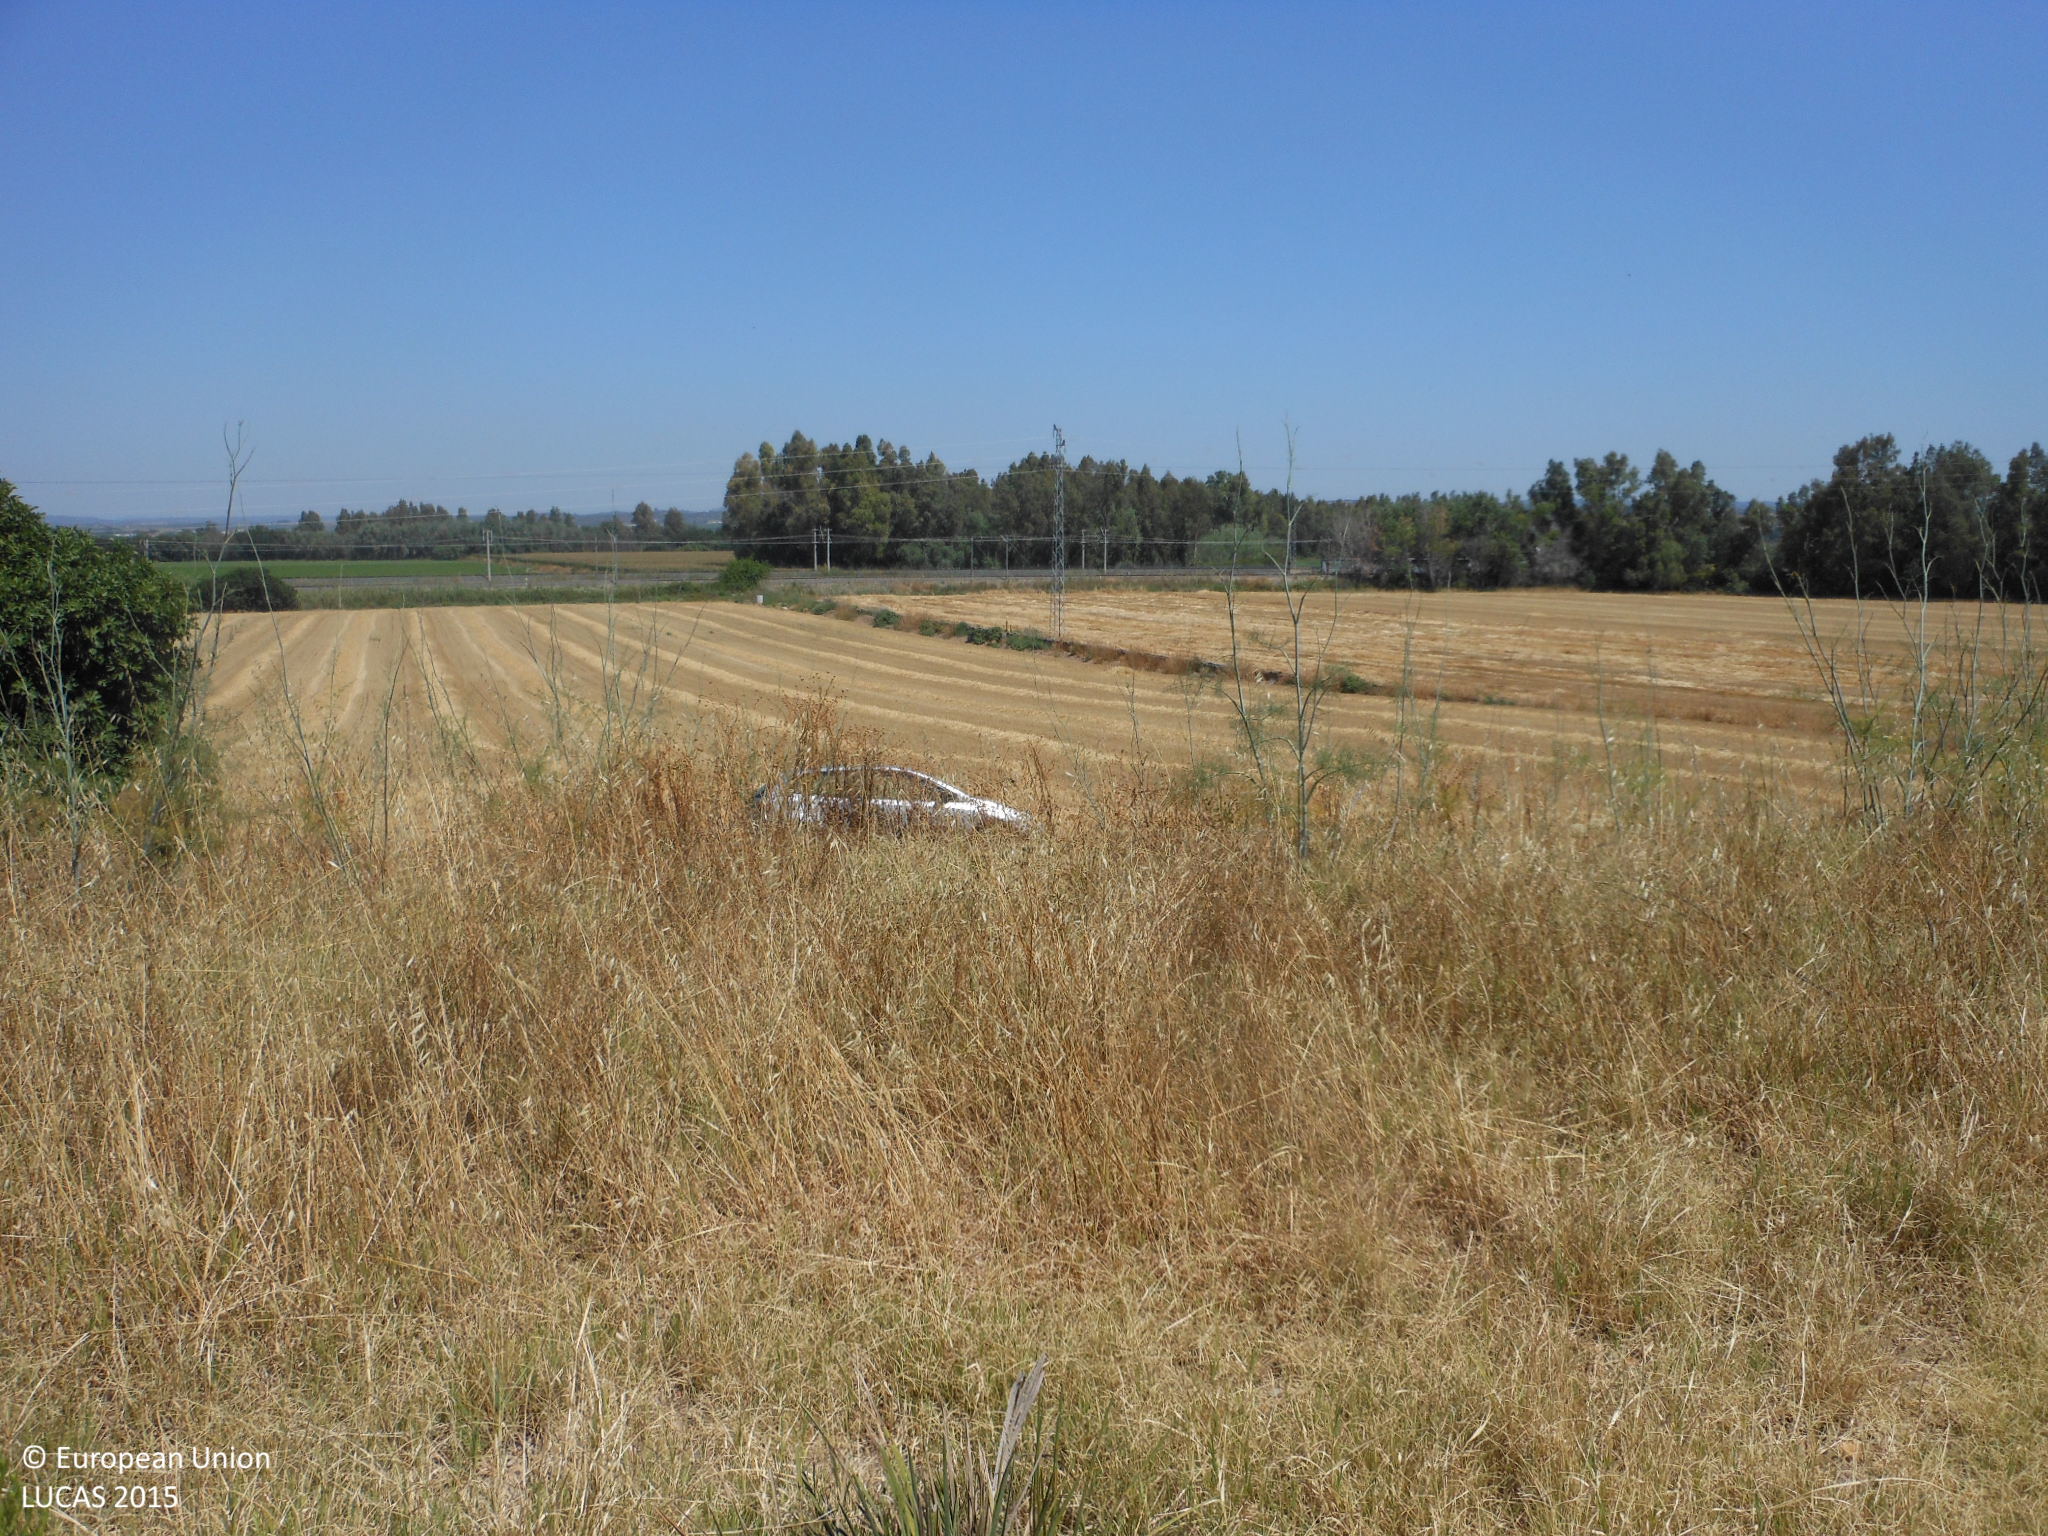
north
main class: Woodland
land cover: Broadleaved woodland
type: exotic forest
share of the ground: 50 - 75 %
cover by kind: broadleaved forest trees 55 %, herbaceous plants 30 %, consolidated bare surface 15 %
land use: Semi-natural and natural areas not in use
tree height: > 5 m
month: June
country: ES
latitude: 37.5874
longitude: -5.6385
